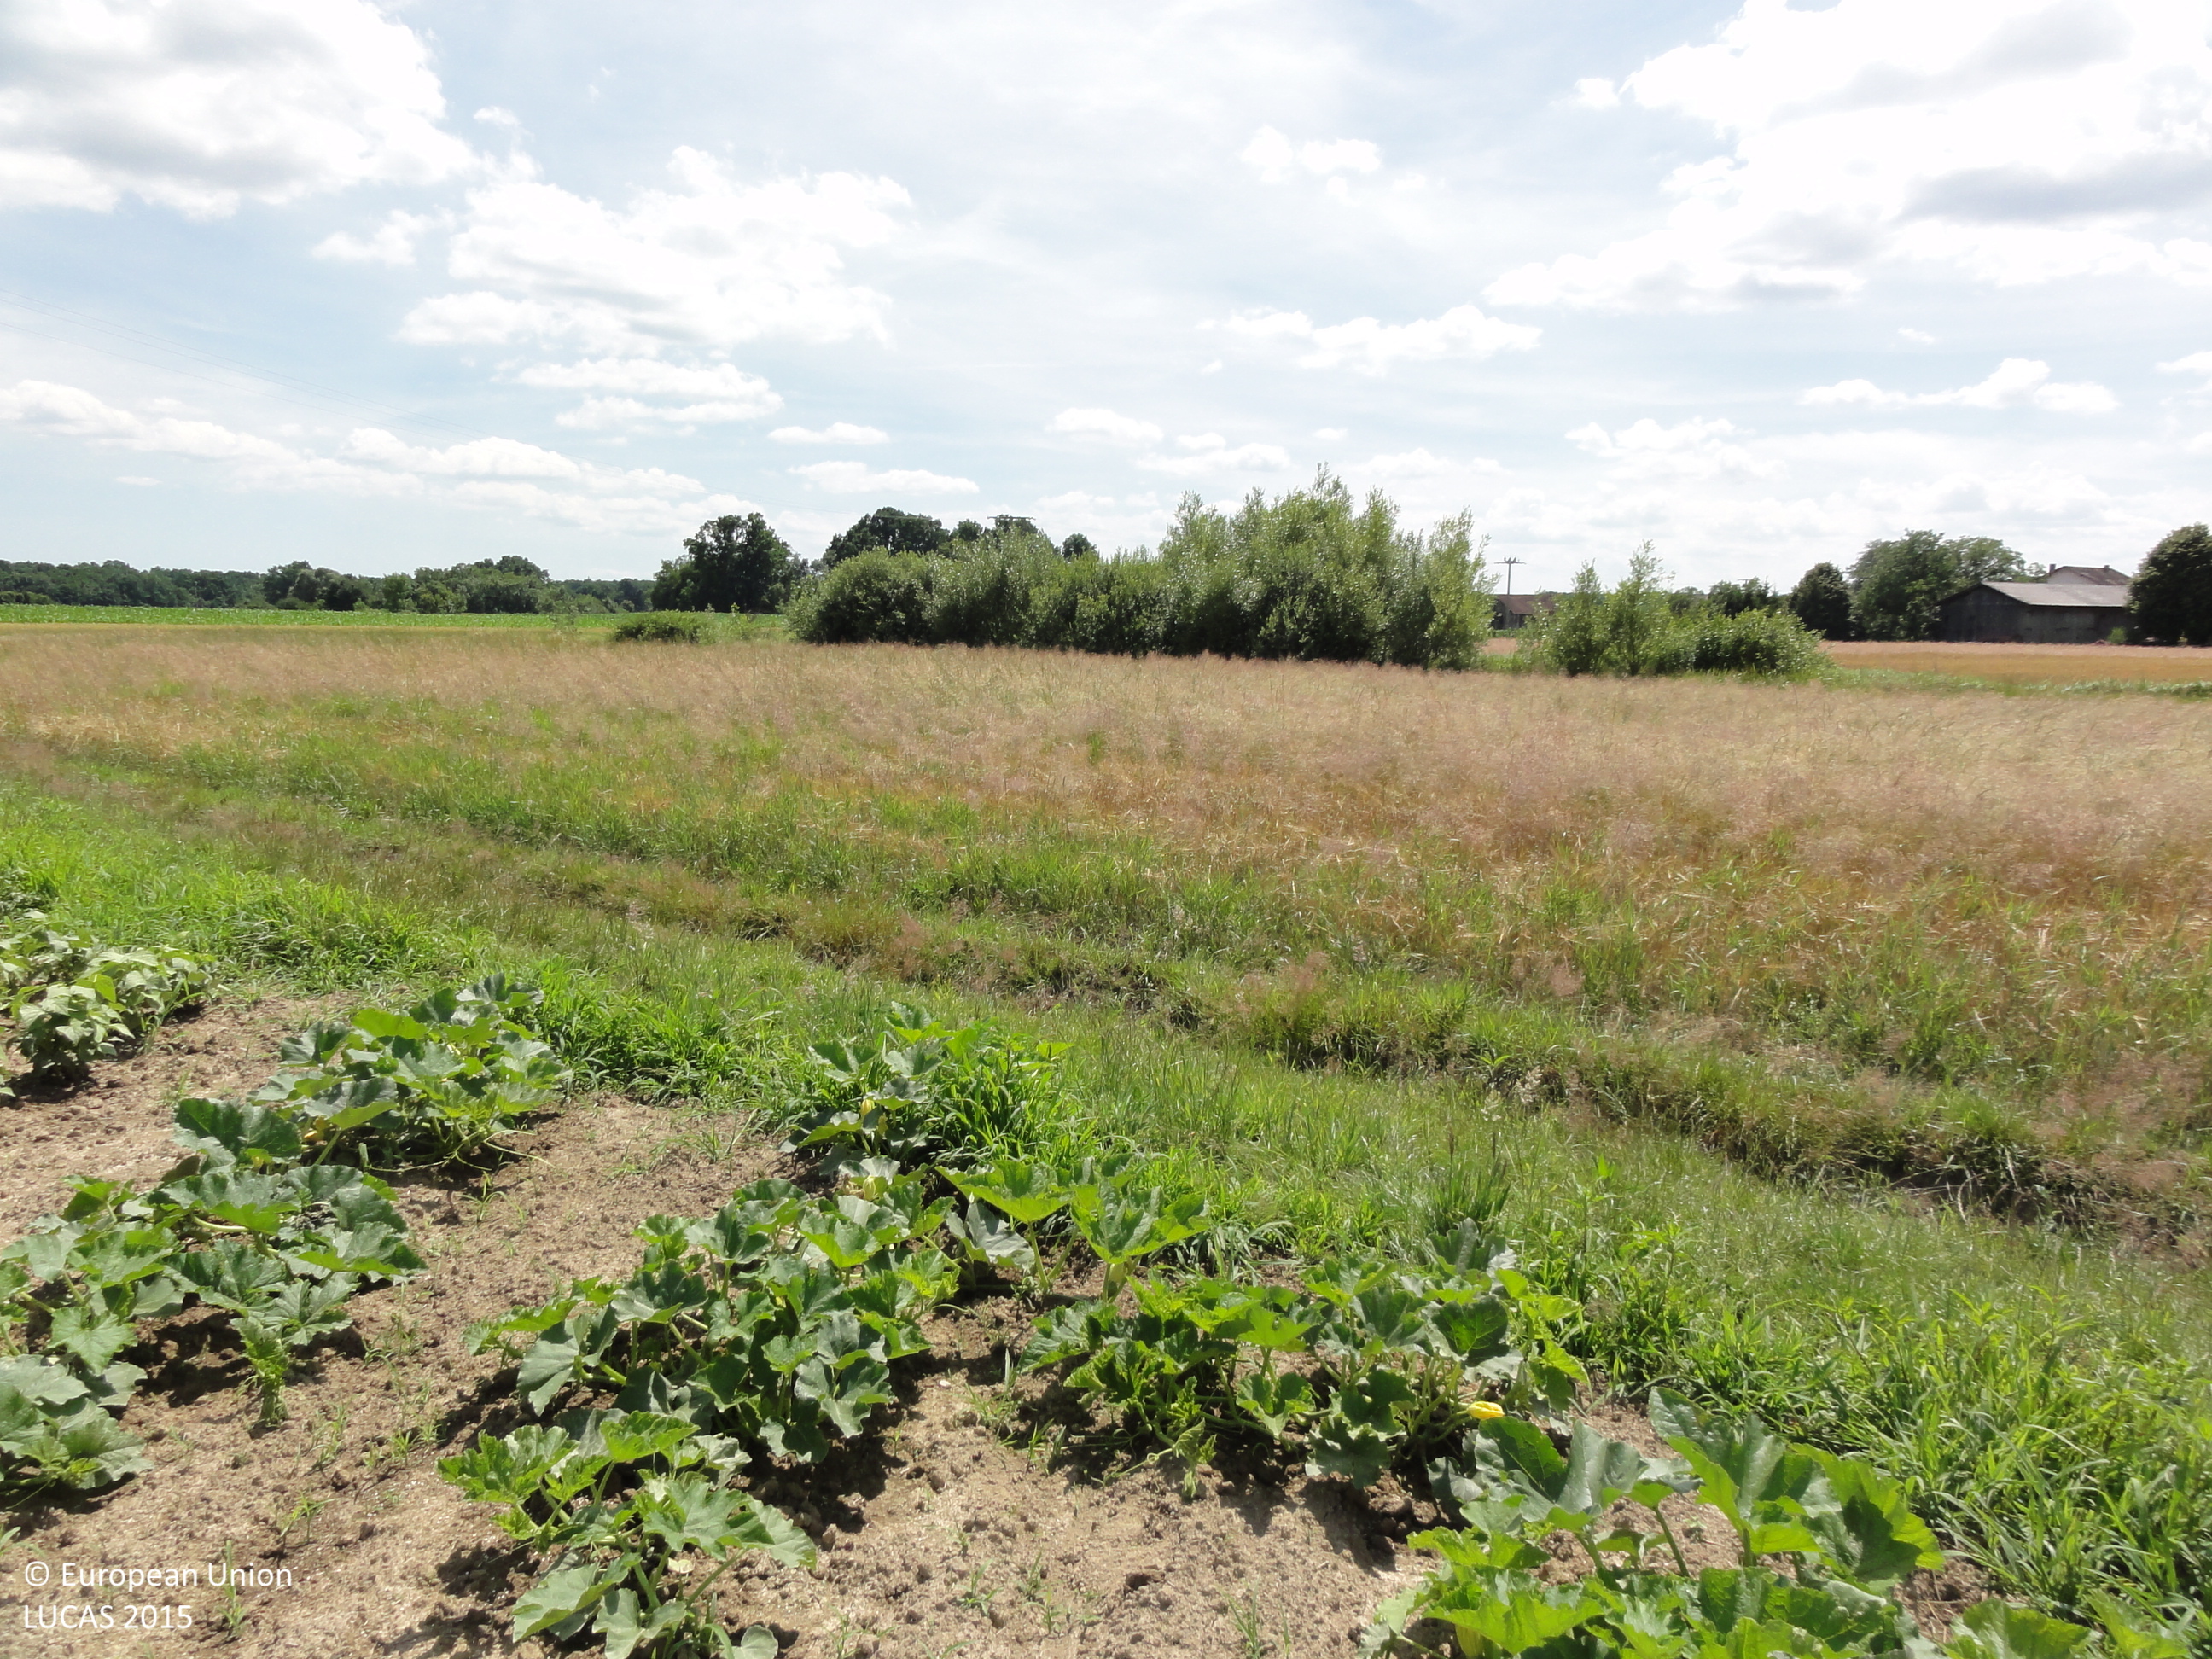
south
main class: Cropland
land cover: Other fibre and oleaginous crops
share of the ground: 25 - 50 %
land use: Agriculture (excluding fallow land and kitchen gardens)
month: June
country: SI
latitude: 46.6120
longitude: 16.3860
